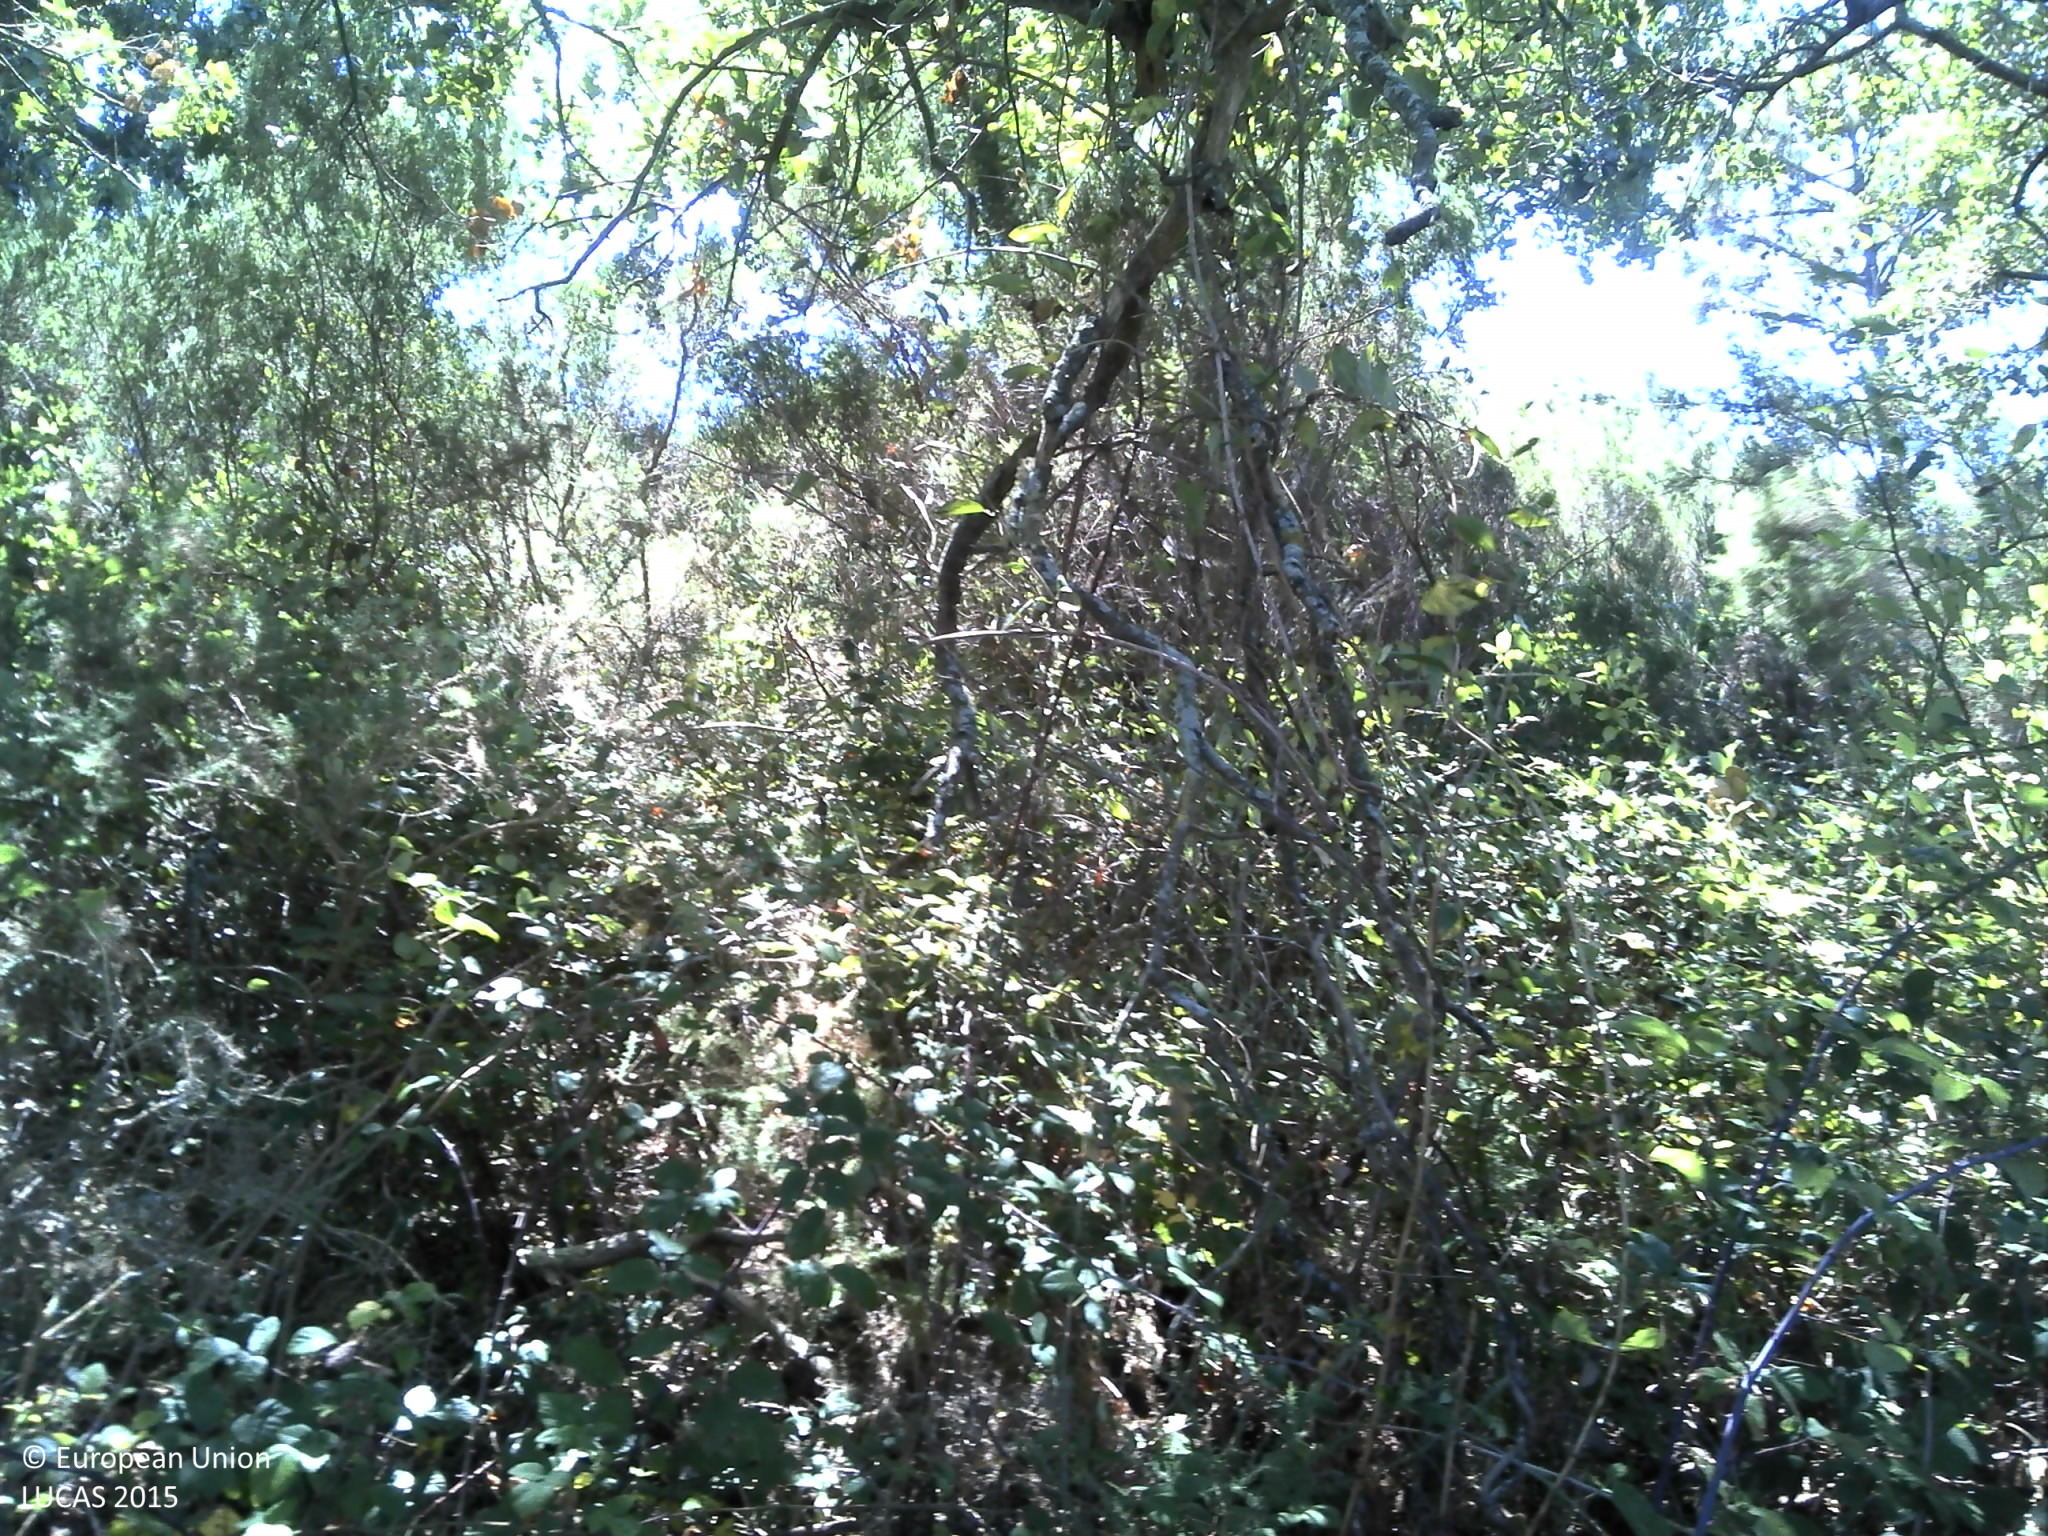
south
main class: Woodland
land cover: Broadleaved woodland
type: broadleaved evergreen forest
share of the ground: 50 - 75 %
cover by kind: broadleaved forest trees 65 %, shrubs 20 %, unconsolidated bare surface 10 %
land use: Forestry
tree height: > 5 m
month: July
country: PT
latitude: 38.9265
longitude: -9.1941
